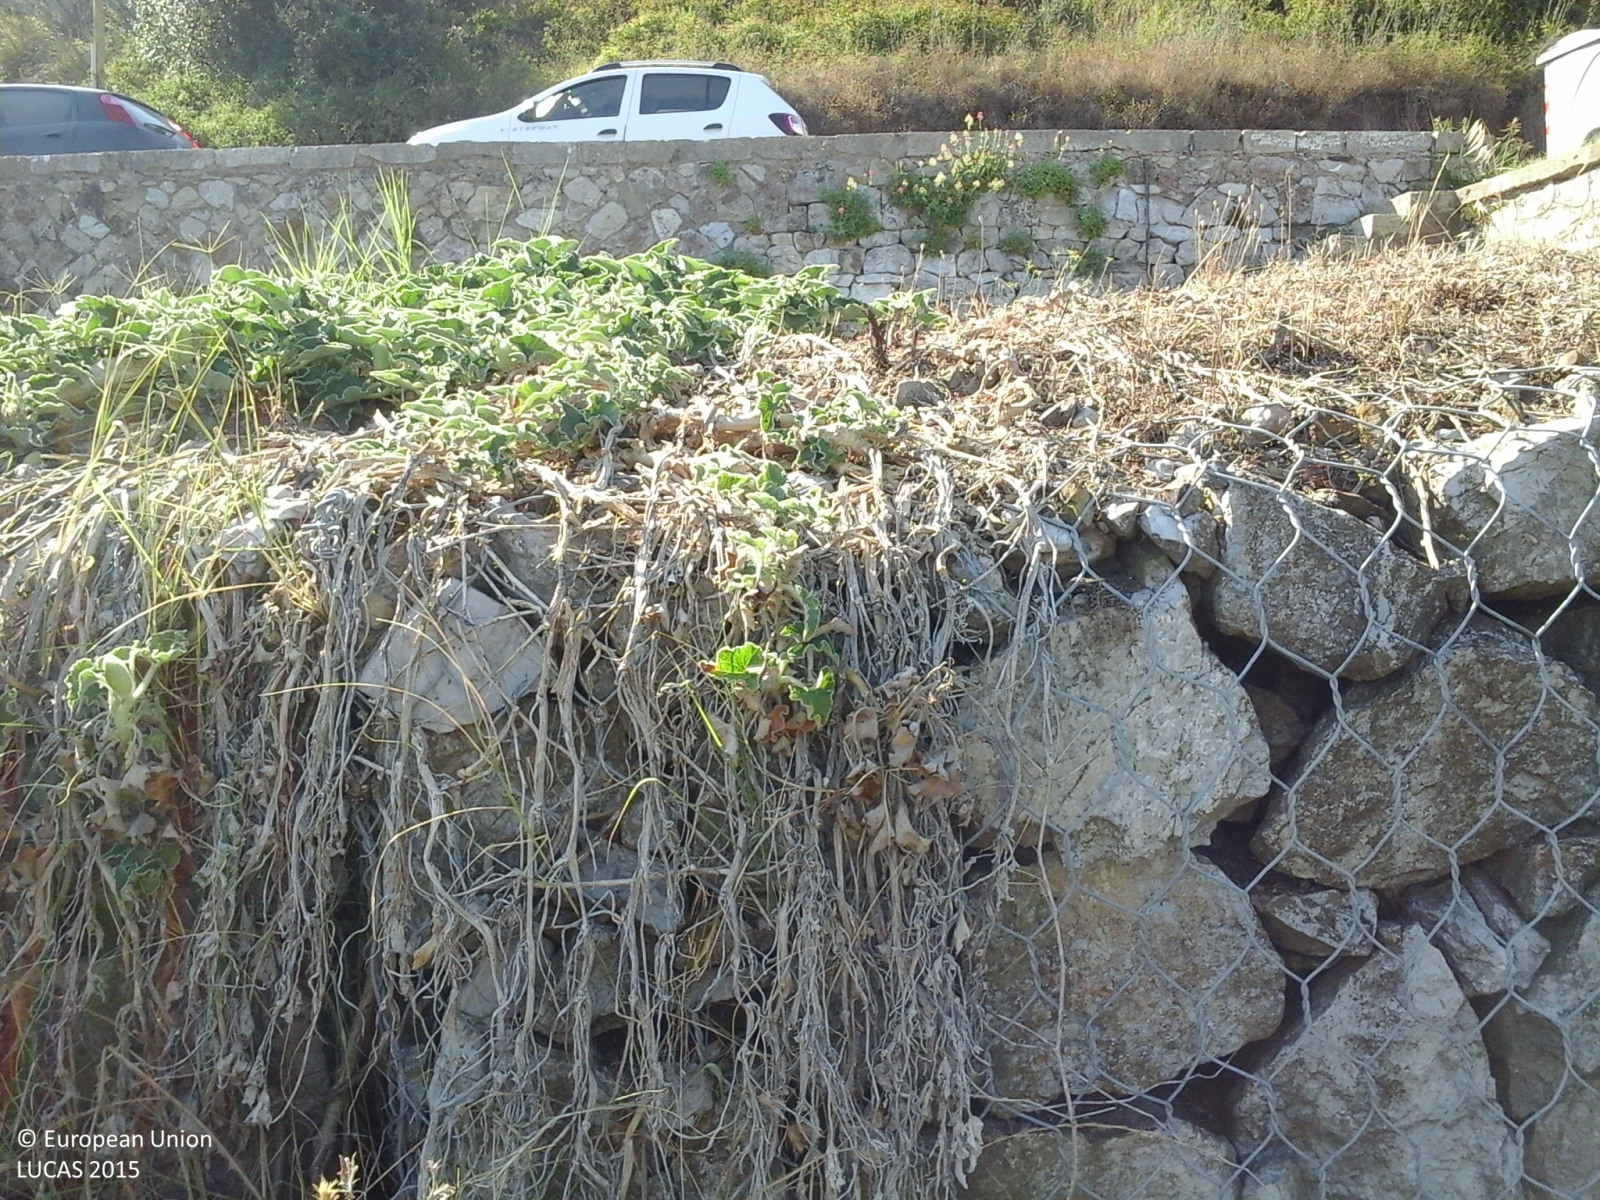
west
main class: Woodland
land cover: Broadleaved woodland
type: broadleaved evergreen forest
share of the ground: > 75 %
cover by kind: broadleaved forest trees 55 %, herbaceous plants 35 %, shrubs 10 %
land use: Semi-natural and natural areas not in use
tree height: < 5 m
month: July
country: IT
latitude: 42.8158
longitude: 10.4023
